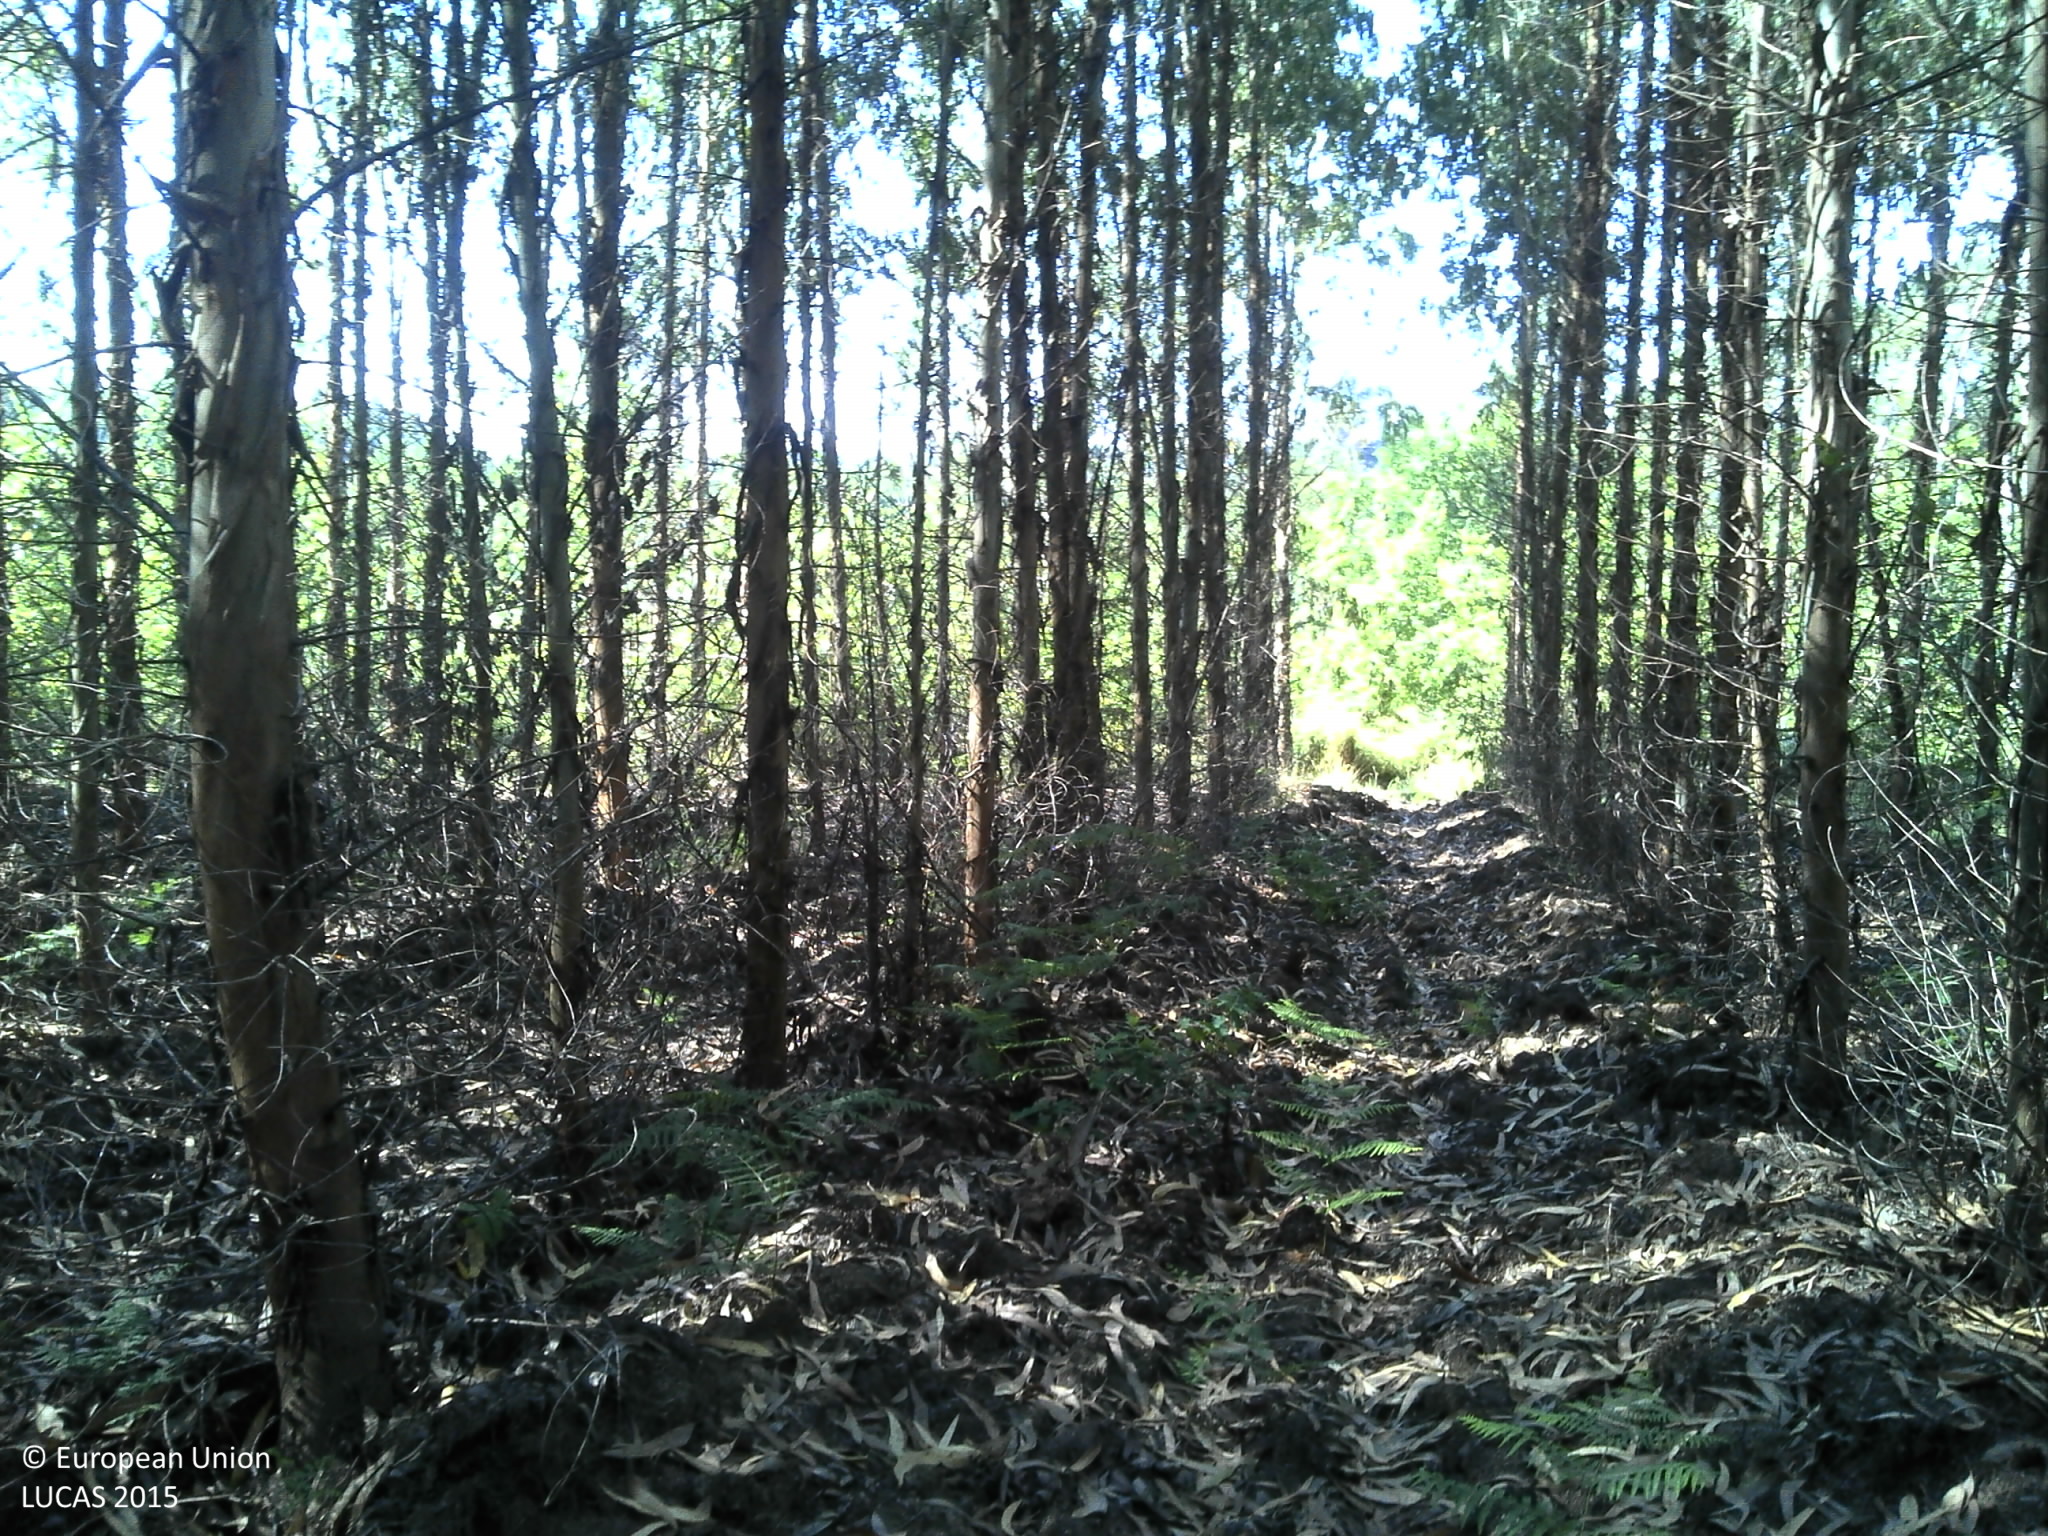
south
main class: Woodland
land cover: Broadleaved woodland
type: exotic forest
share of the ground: > 75 %
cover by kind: broadleaved forest trees 75 %, unconsolidated bare surface 20 %, shrubs 5 %
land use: Forestry
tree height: > 5 m
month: June
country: PT
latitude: 40.5871
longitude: -8.0746
